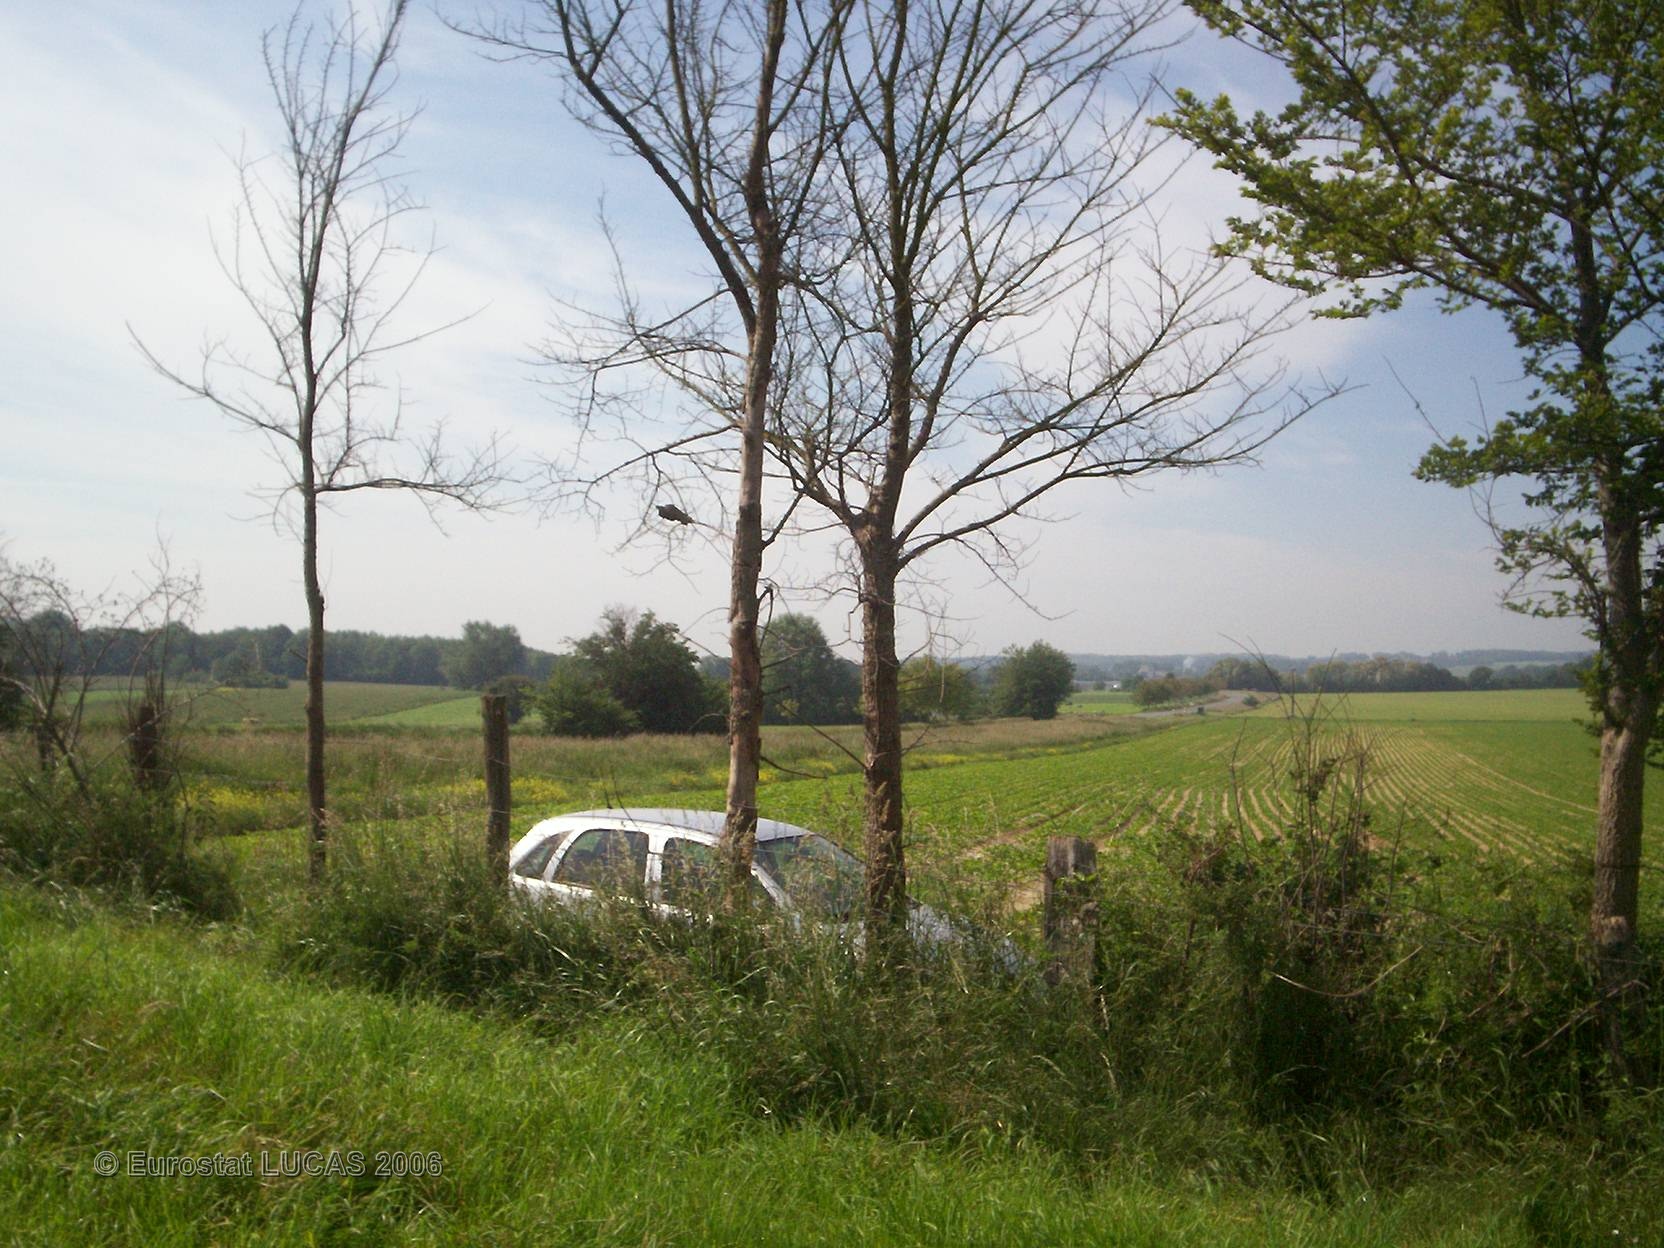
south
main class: Grassland
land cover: Grassland without tree/shrub cover
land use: Agriculture (excluding fallow land and kitchen gardens)
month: June
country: FR
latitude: 49.5710
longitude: 2.7016
